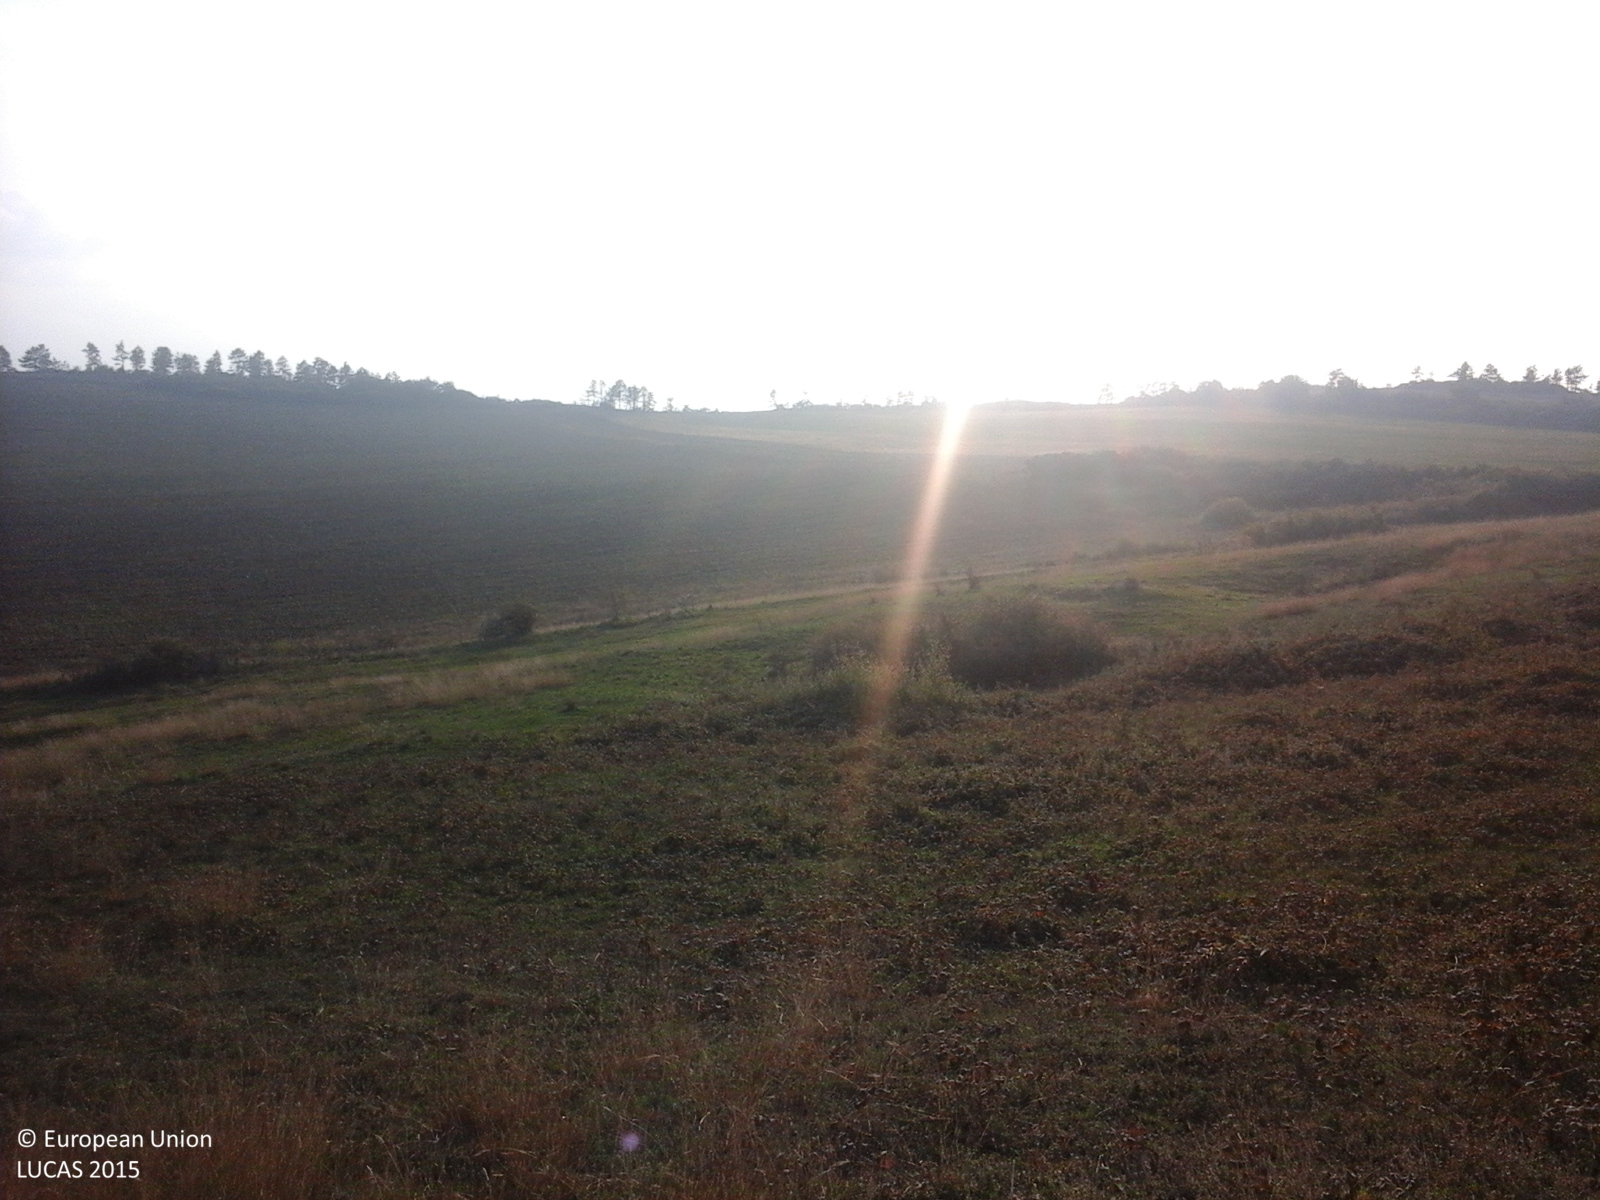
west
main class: Grassland
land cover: Grassland without tree/shrub cover
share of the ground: > 75 %
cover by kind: herbaceous plants 100 %
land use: Agriculture (excluding fallow land and kitchen gardens)
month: October
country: RO
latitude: 46.4876
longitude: 23.9765
